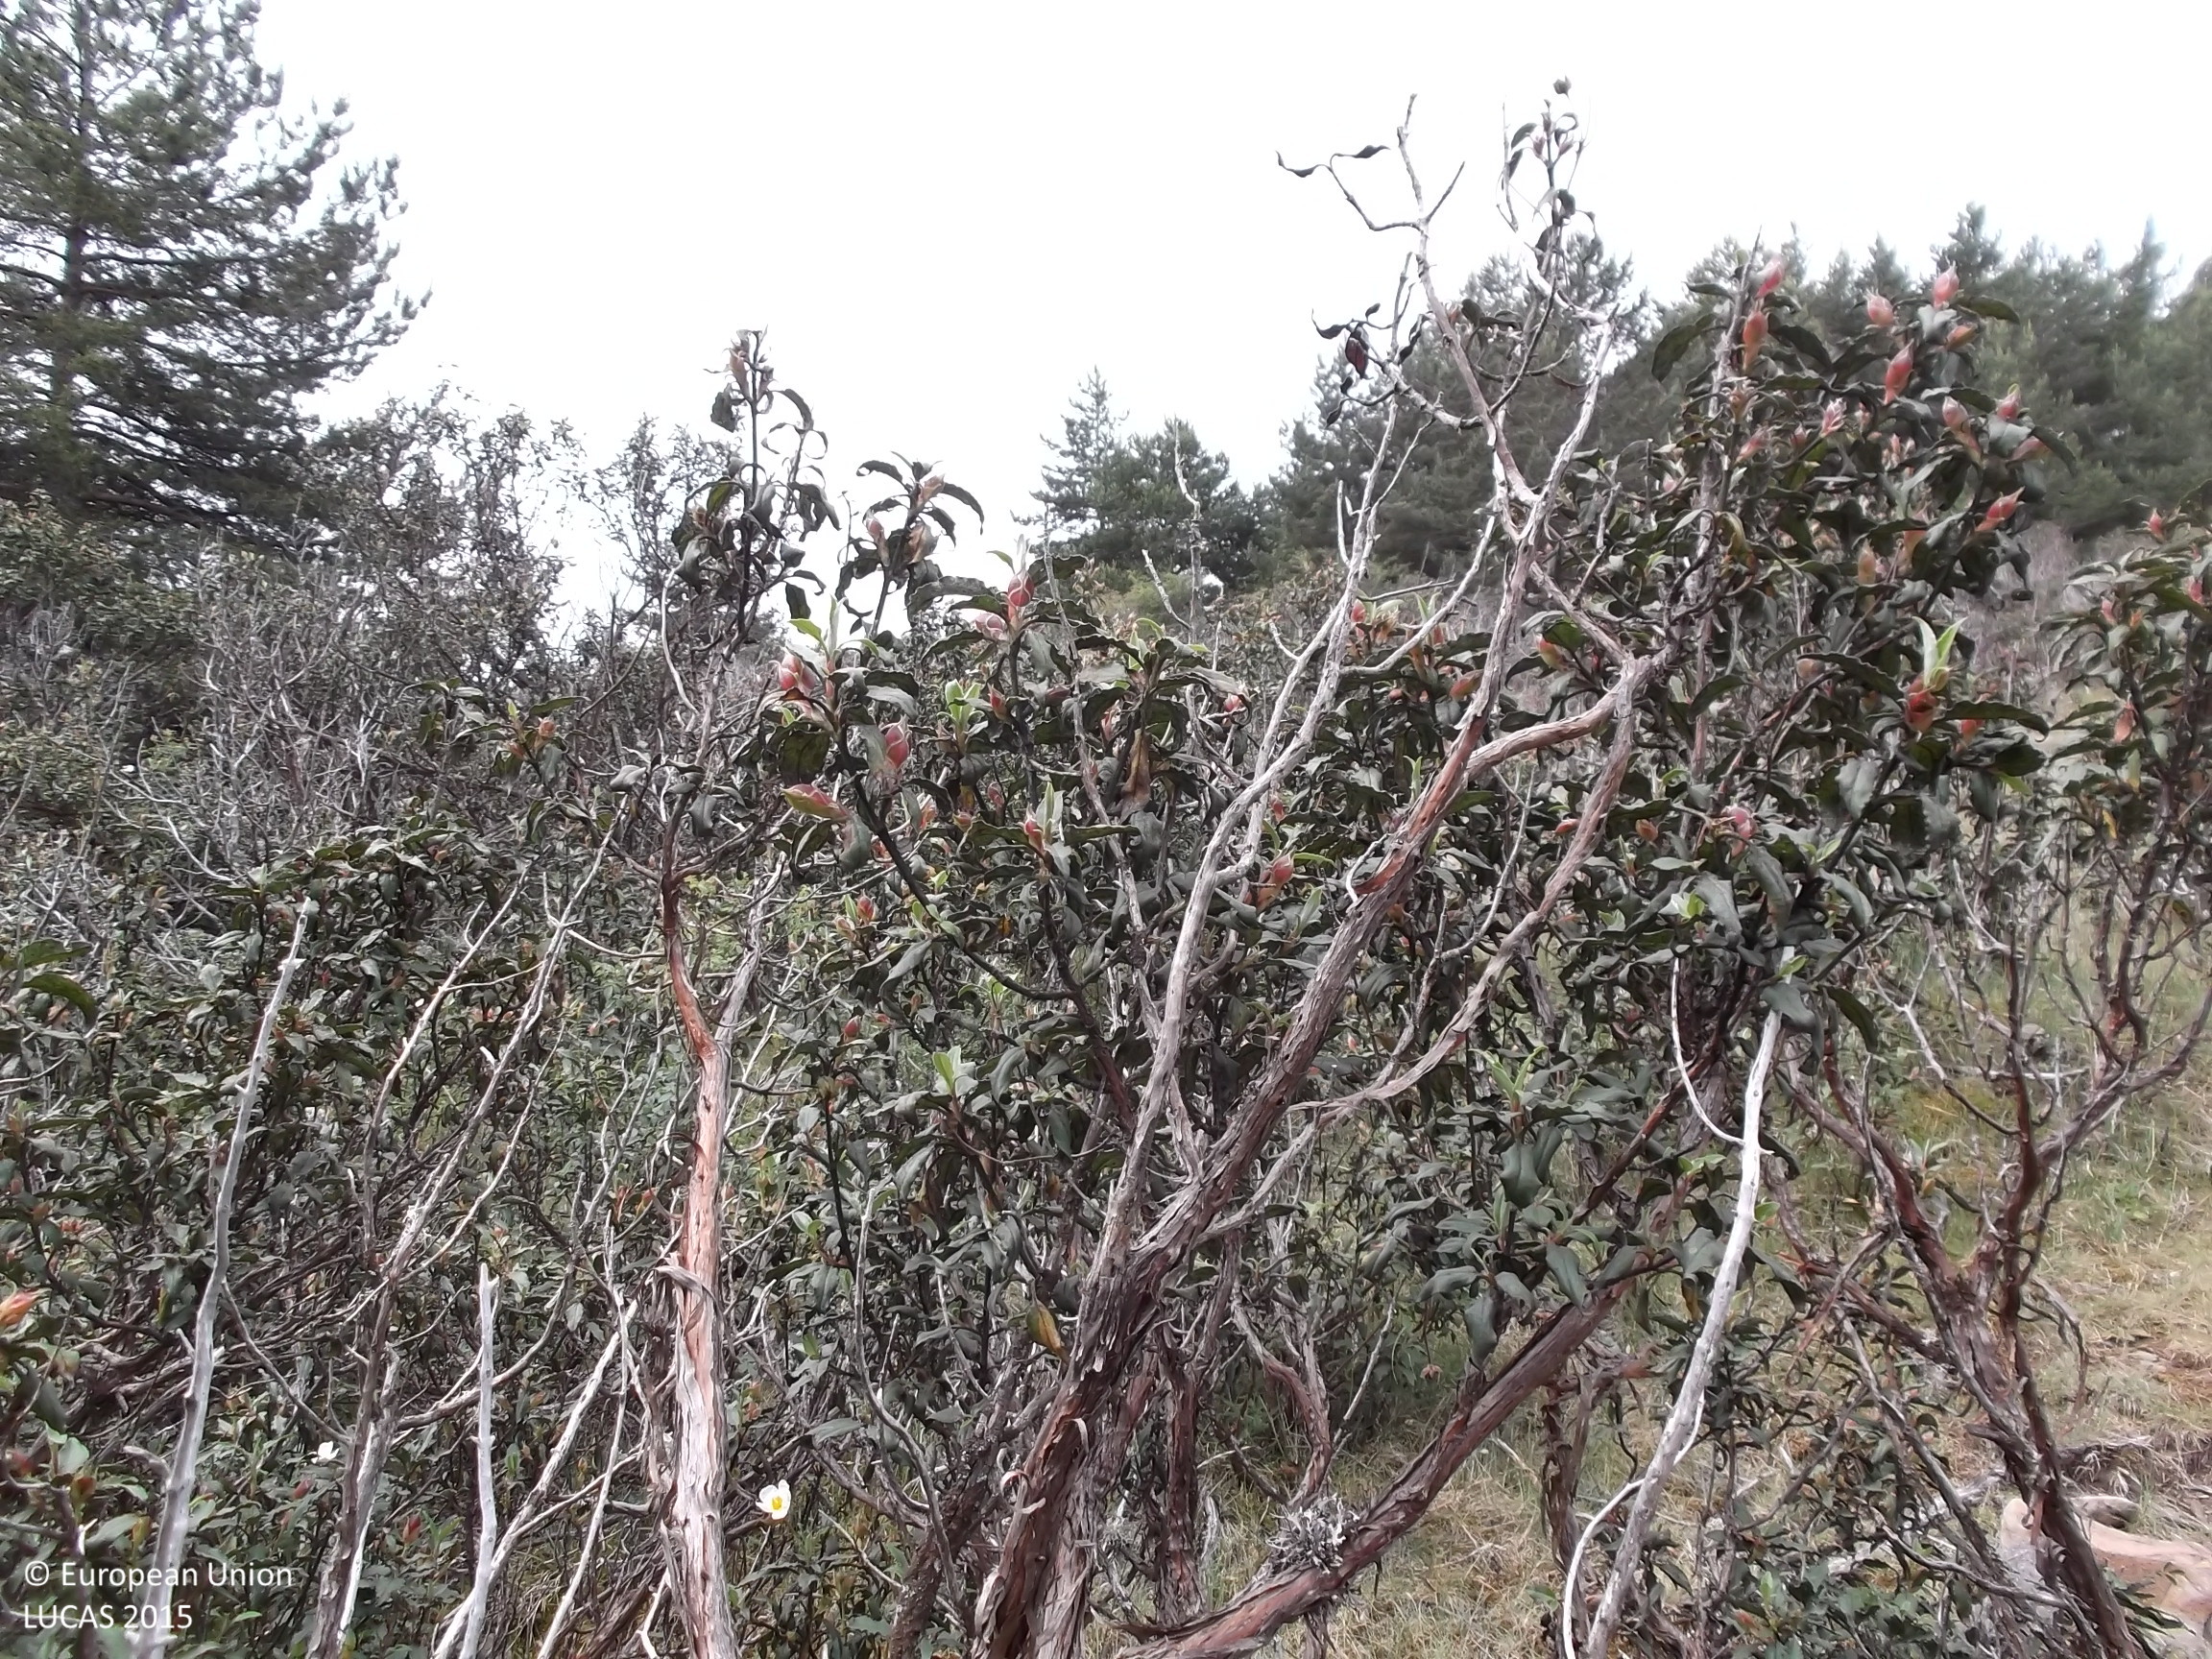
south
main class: Shrubland
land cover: Shrubland without tree cover
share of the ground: > 75 %
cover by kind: shrubs 80 %, herbaceous plants 15 %
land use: Agriculture (excluding fallow land and kitchen gardens)
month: June
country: ES
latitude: 42.2191
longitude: -2.3863
